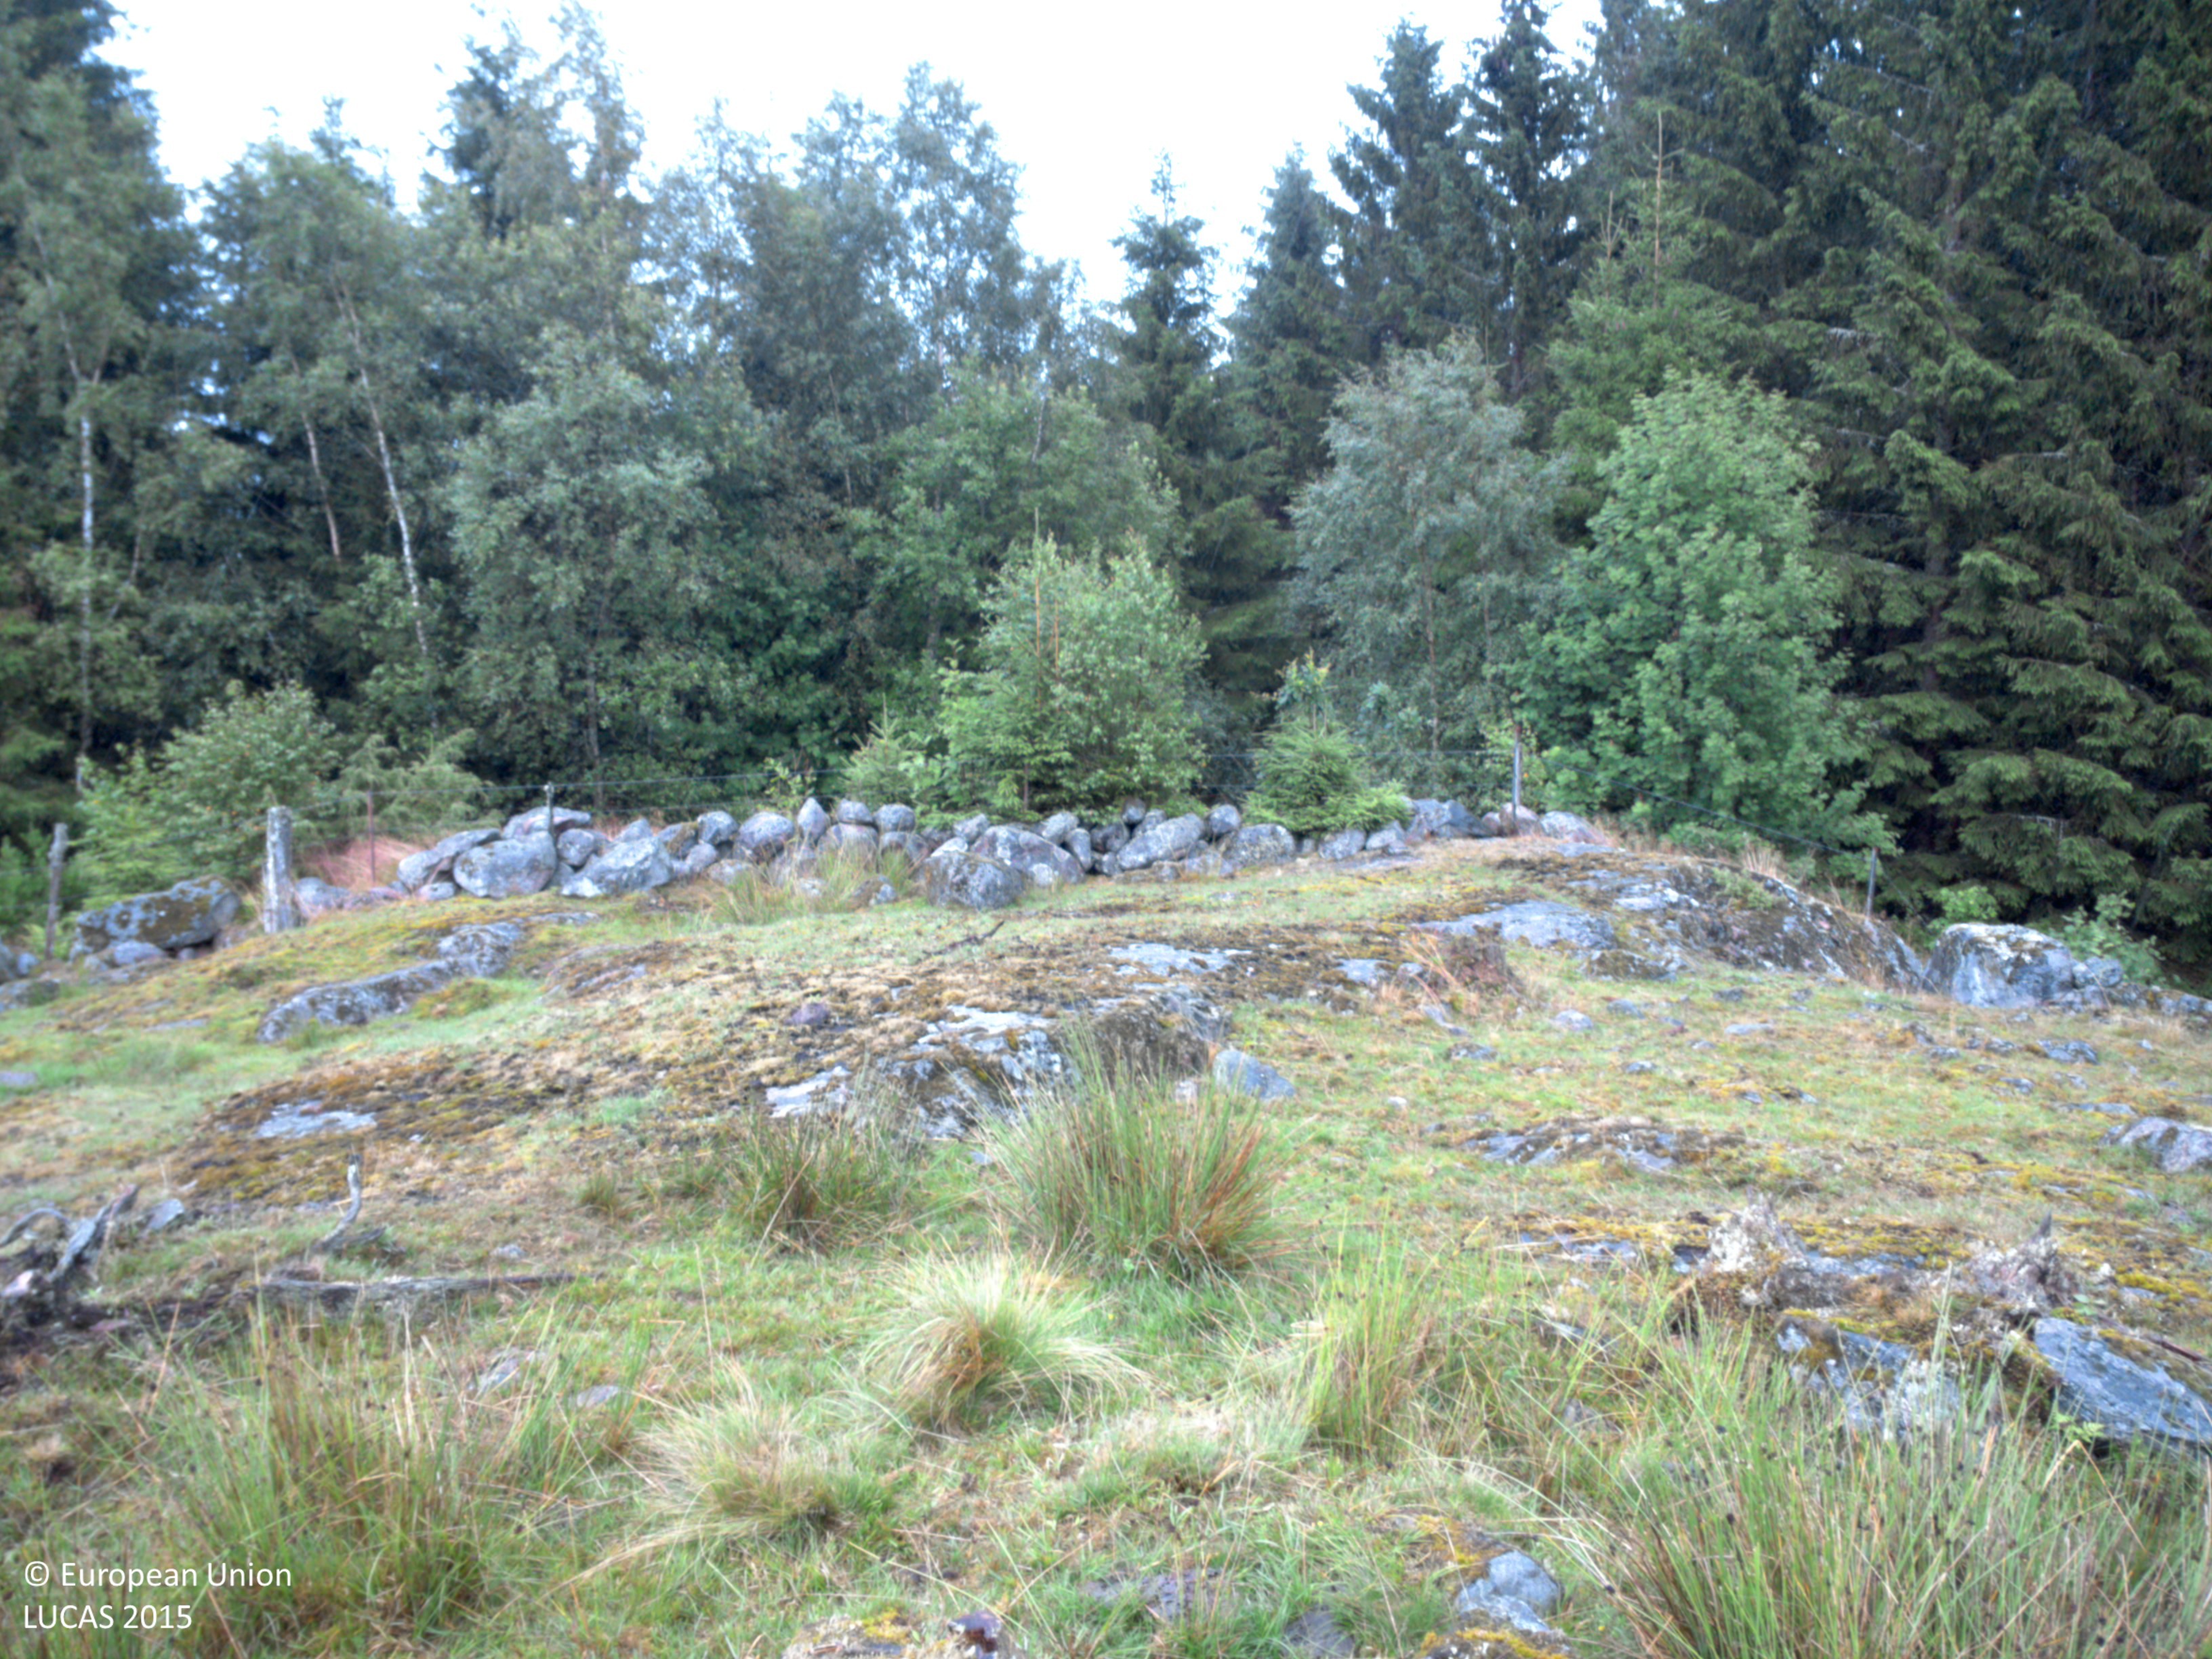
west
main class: Grassland
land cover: Grassland with sparse tree/shrub cover
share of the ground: > 75 %
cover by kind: herbaceous plants 75 %, consolidated bare surface 20 %, broadleaved forest trees 5 %
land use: Agriculture (excluding fallow land and kitchen gardens)
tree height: < 5 m
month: July
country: SE
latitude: 58.3111
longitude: 12.0952
